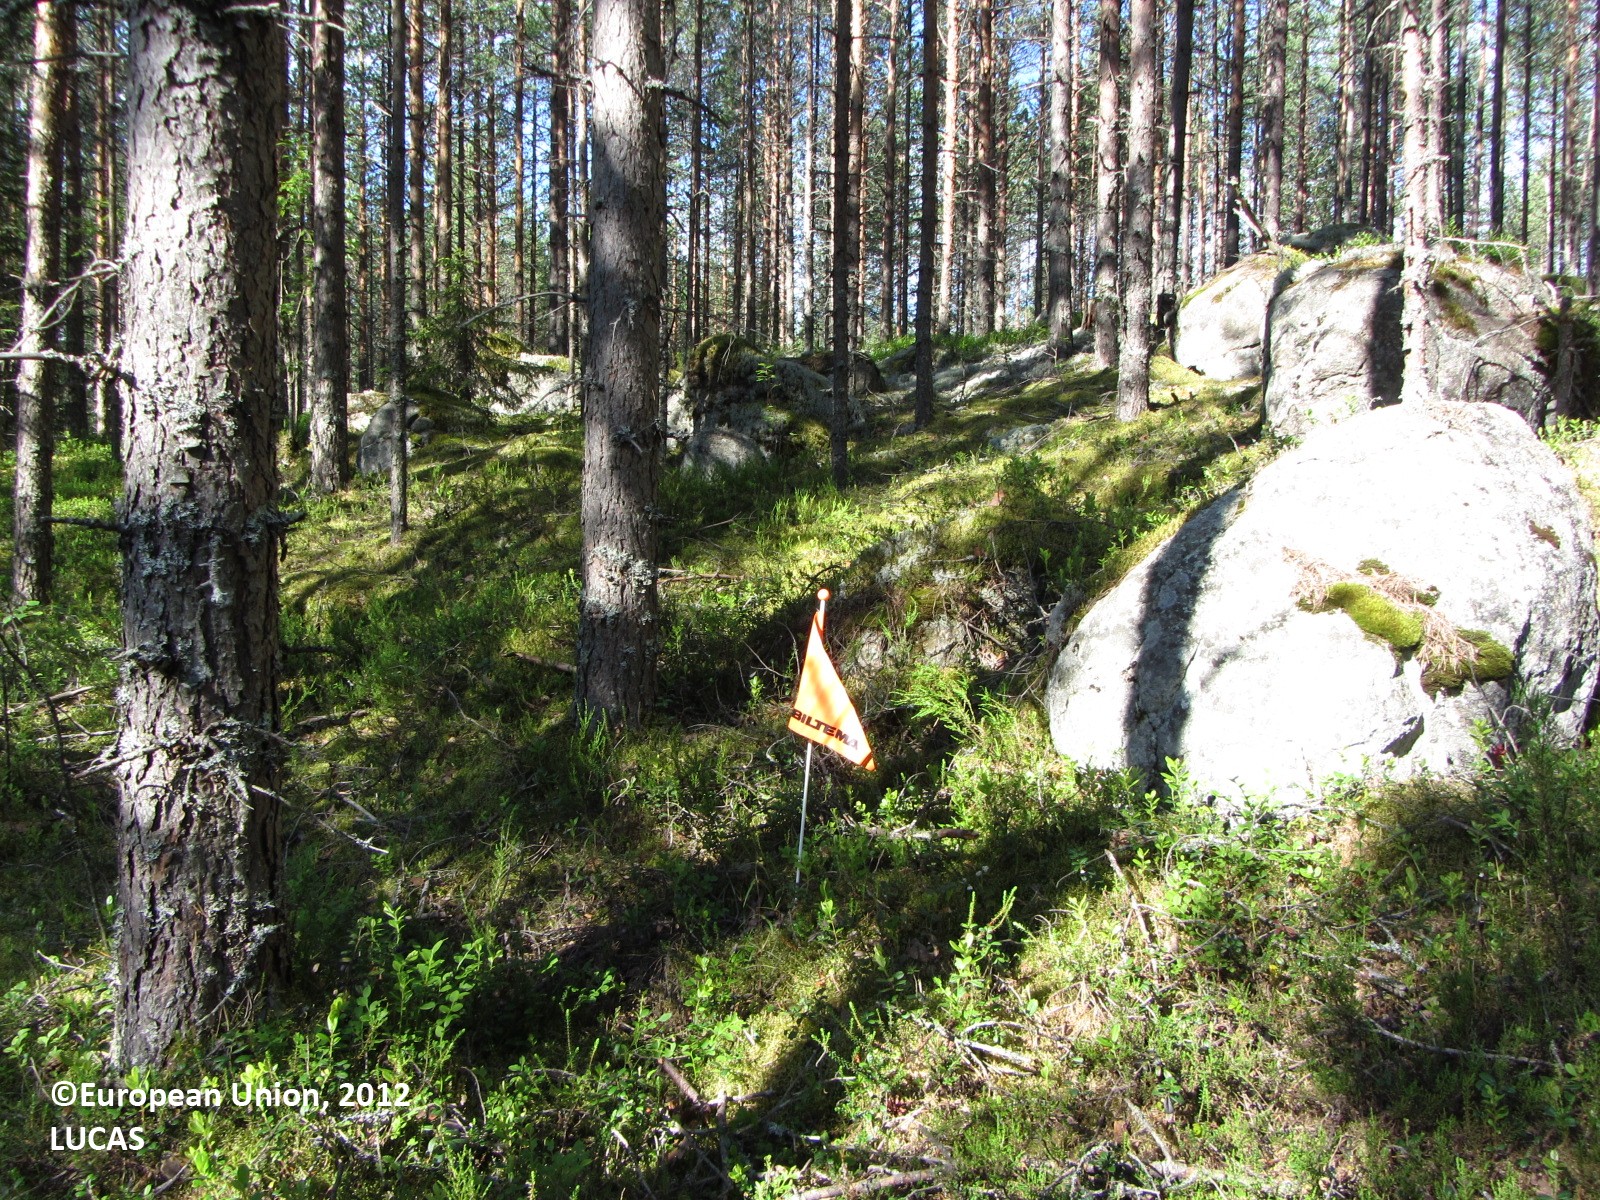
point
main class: Woodland
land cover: Pine dominated coniferous woodland
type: boreal forest
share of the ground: 25 - 50 %
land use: Forestry
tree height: > 5 m
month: July
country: FI
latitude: 62.8142
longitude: 25.3491
